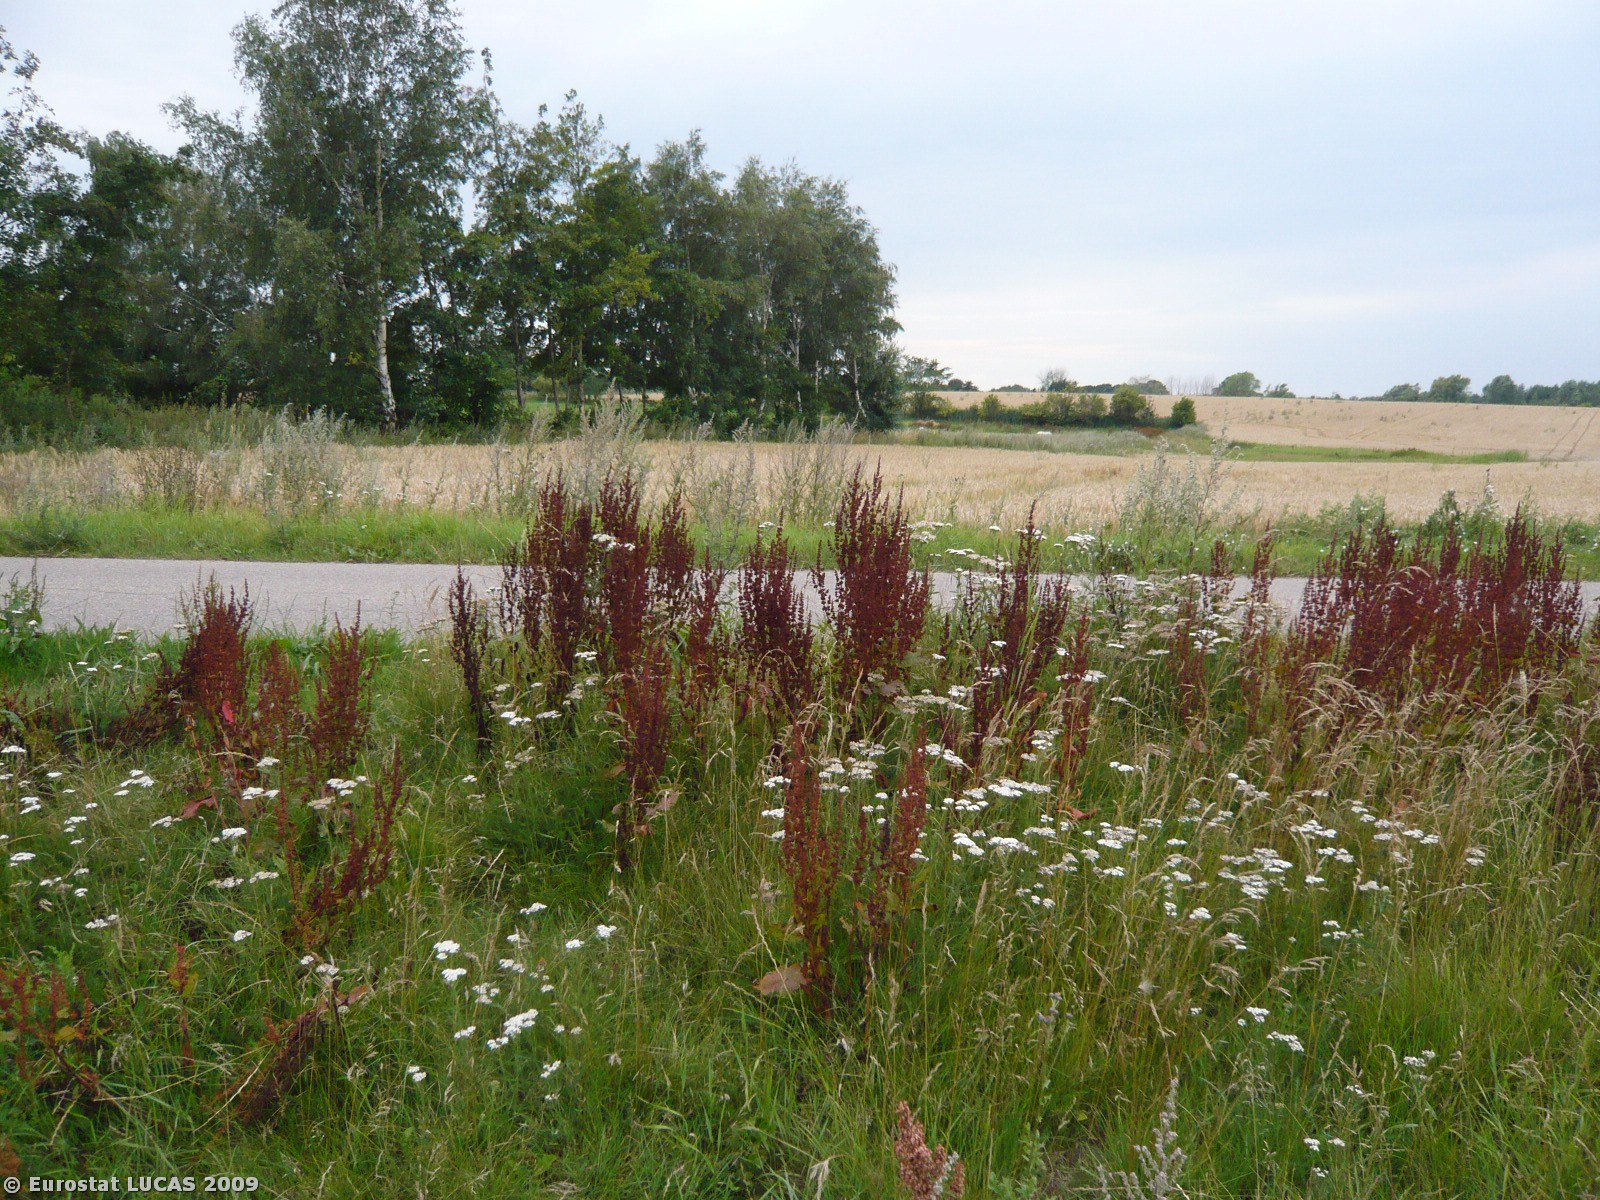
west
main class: Cropland
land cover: Barley
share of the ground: > 75 %
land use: Agriculture (excluding fallow land and kitchen gardens)
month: July
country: DK
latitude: 55.8830
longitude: 12.0923
